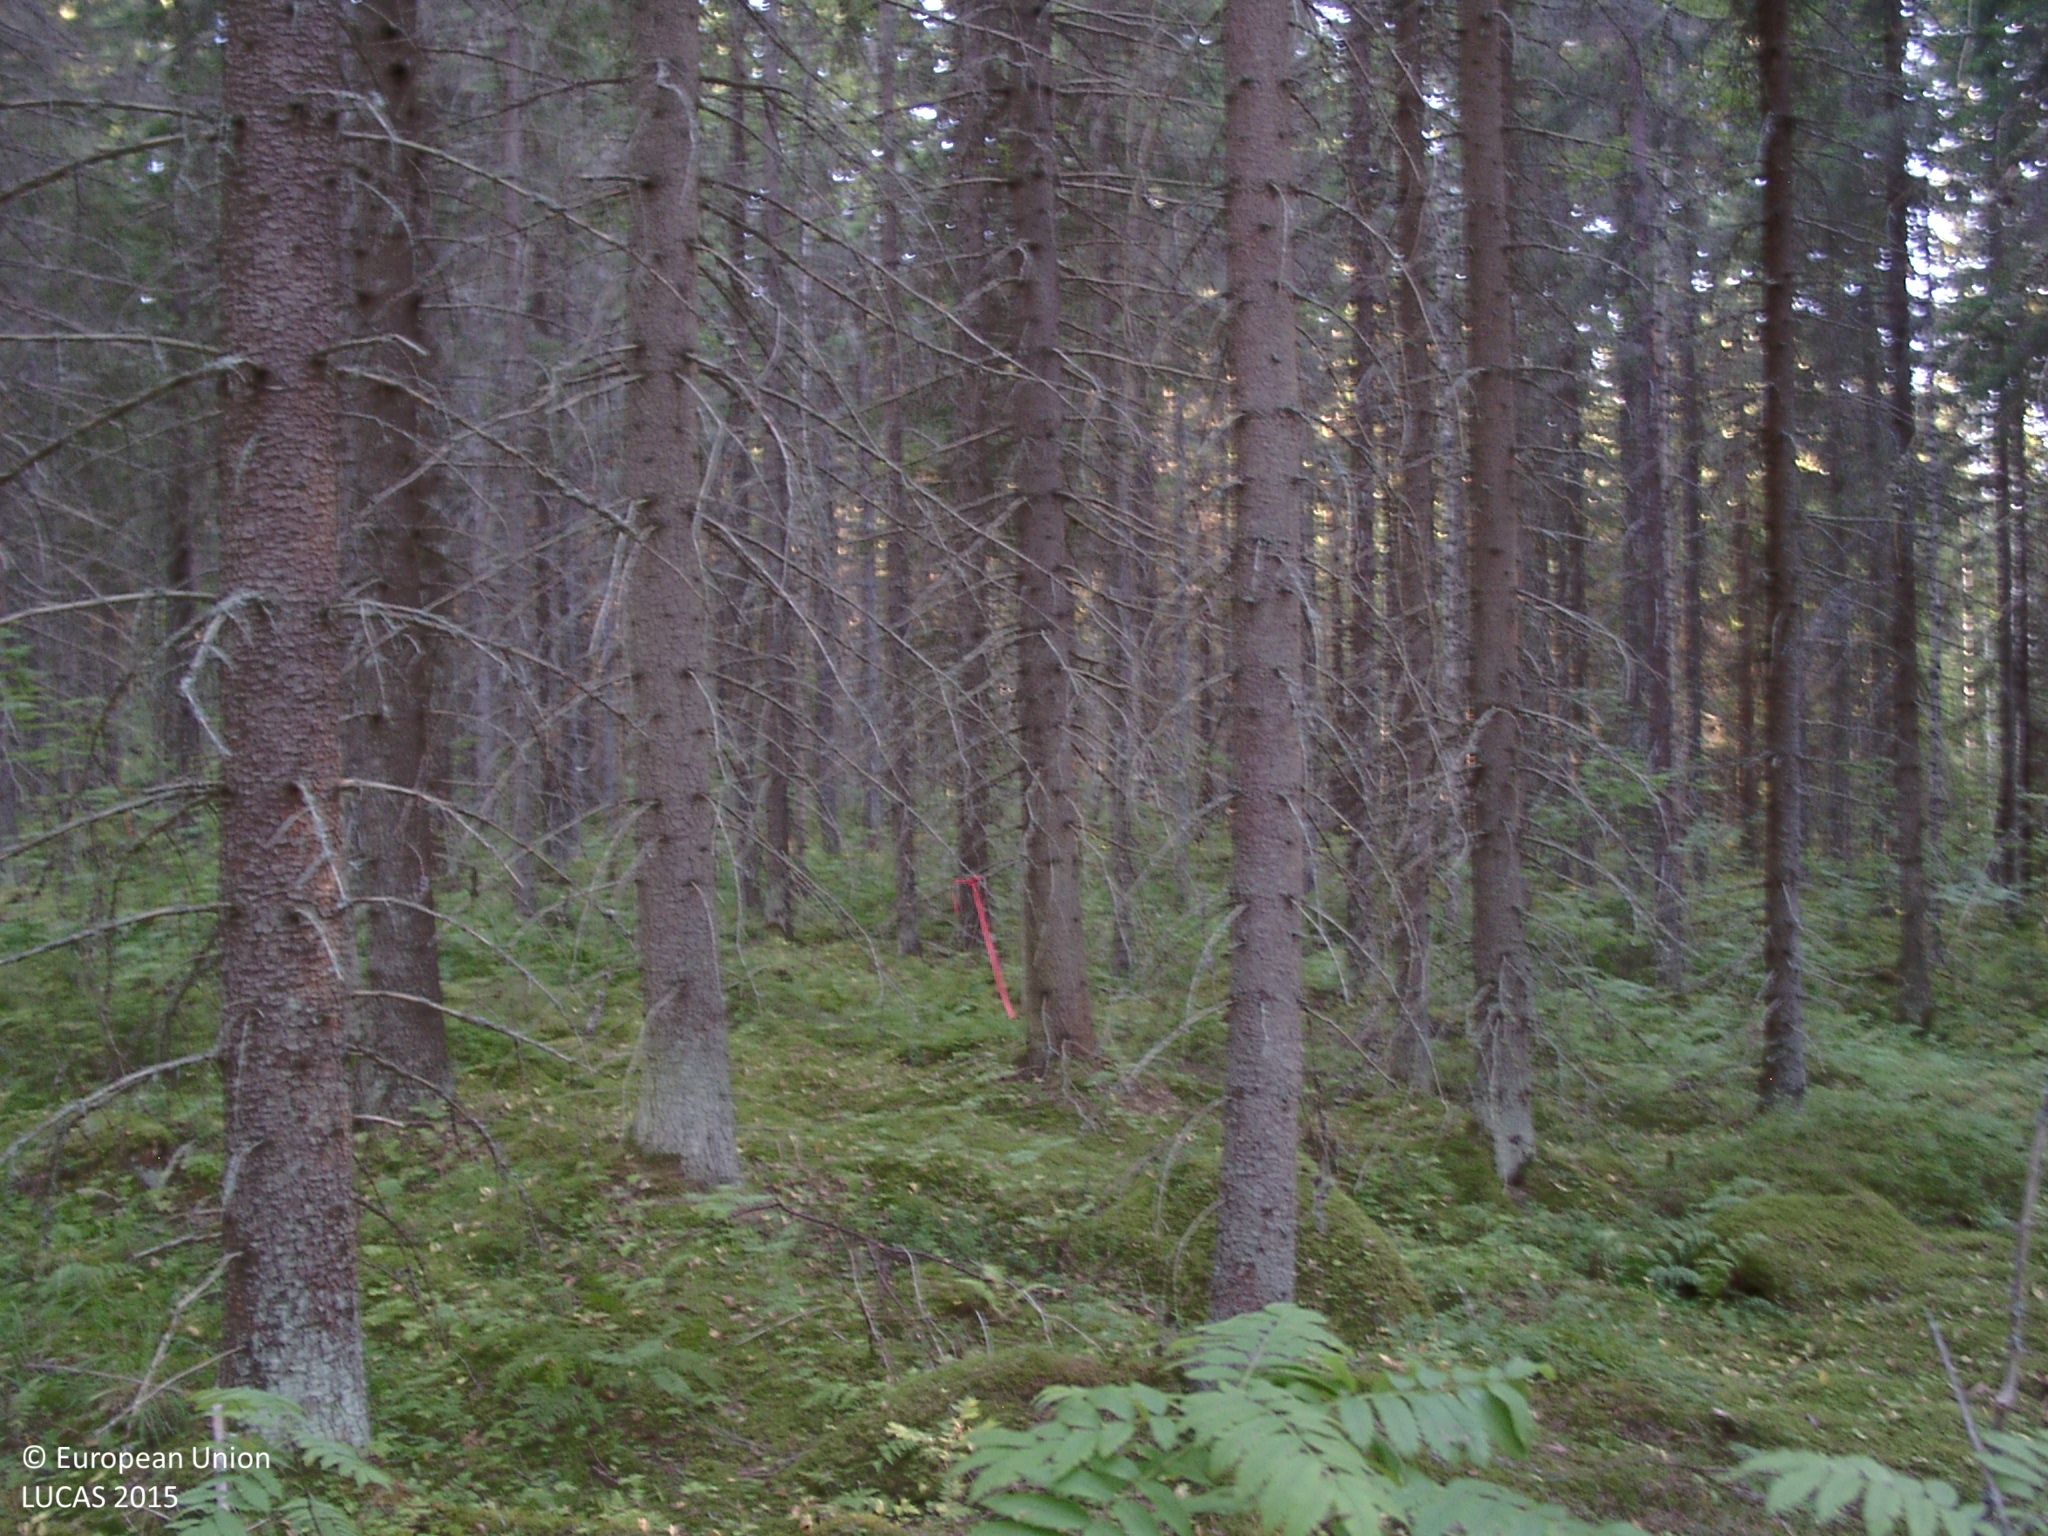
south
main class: Woodland
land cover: Spruce dominated coniferous woodland
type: boreal forest
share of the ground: > 75 %
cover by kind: coniferous forest trees 75 %, broadleaved forest trees 10 %, lichens and mosses 10 %, herbaceous plants 5 %
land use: Forestry
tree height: > 5 m
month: August
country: FI
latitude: 62.0002
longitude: 25.0177
